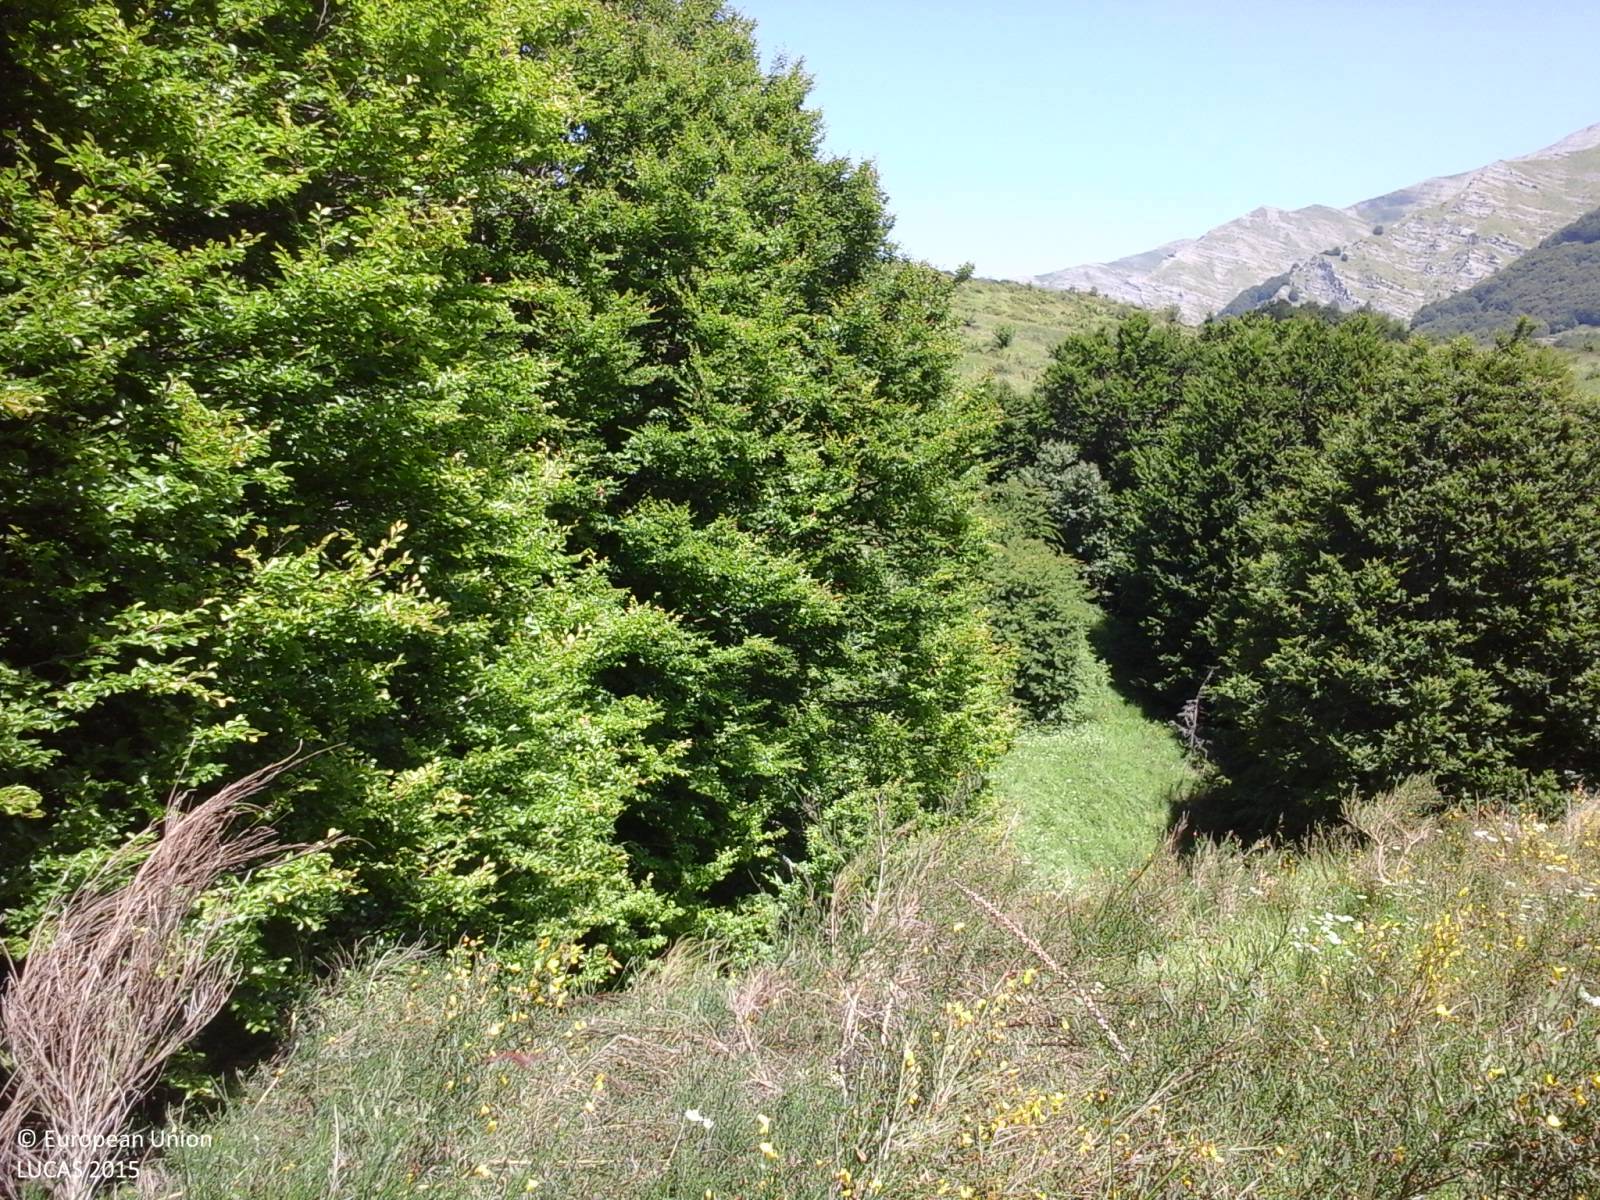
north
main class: Shrubland
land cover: Shrubland without tree cover
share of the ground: > 75 %
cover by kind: herbaceous plants 80 %, shrubs 20 %
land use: Semi-natural and natural areas not in use
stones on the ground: < 10 %
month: September
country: IT
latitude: 42.5801
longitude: 13.3647
